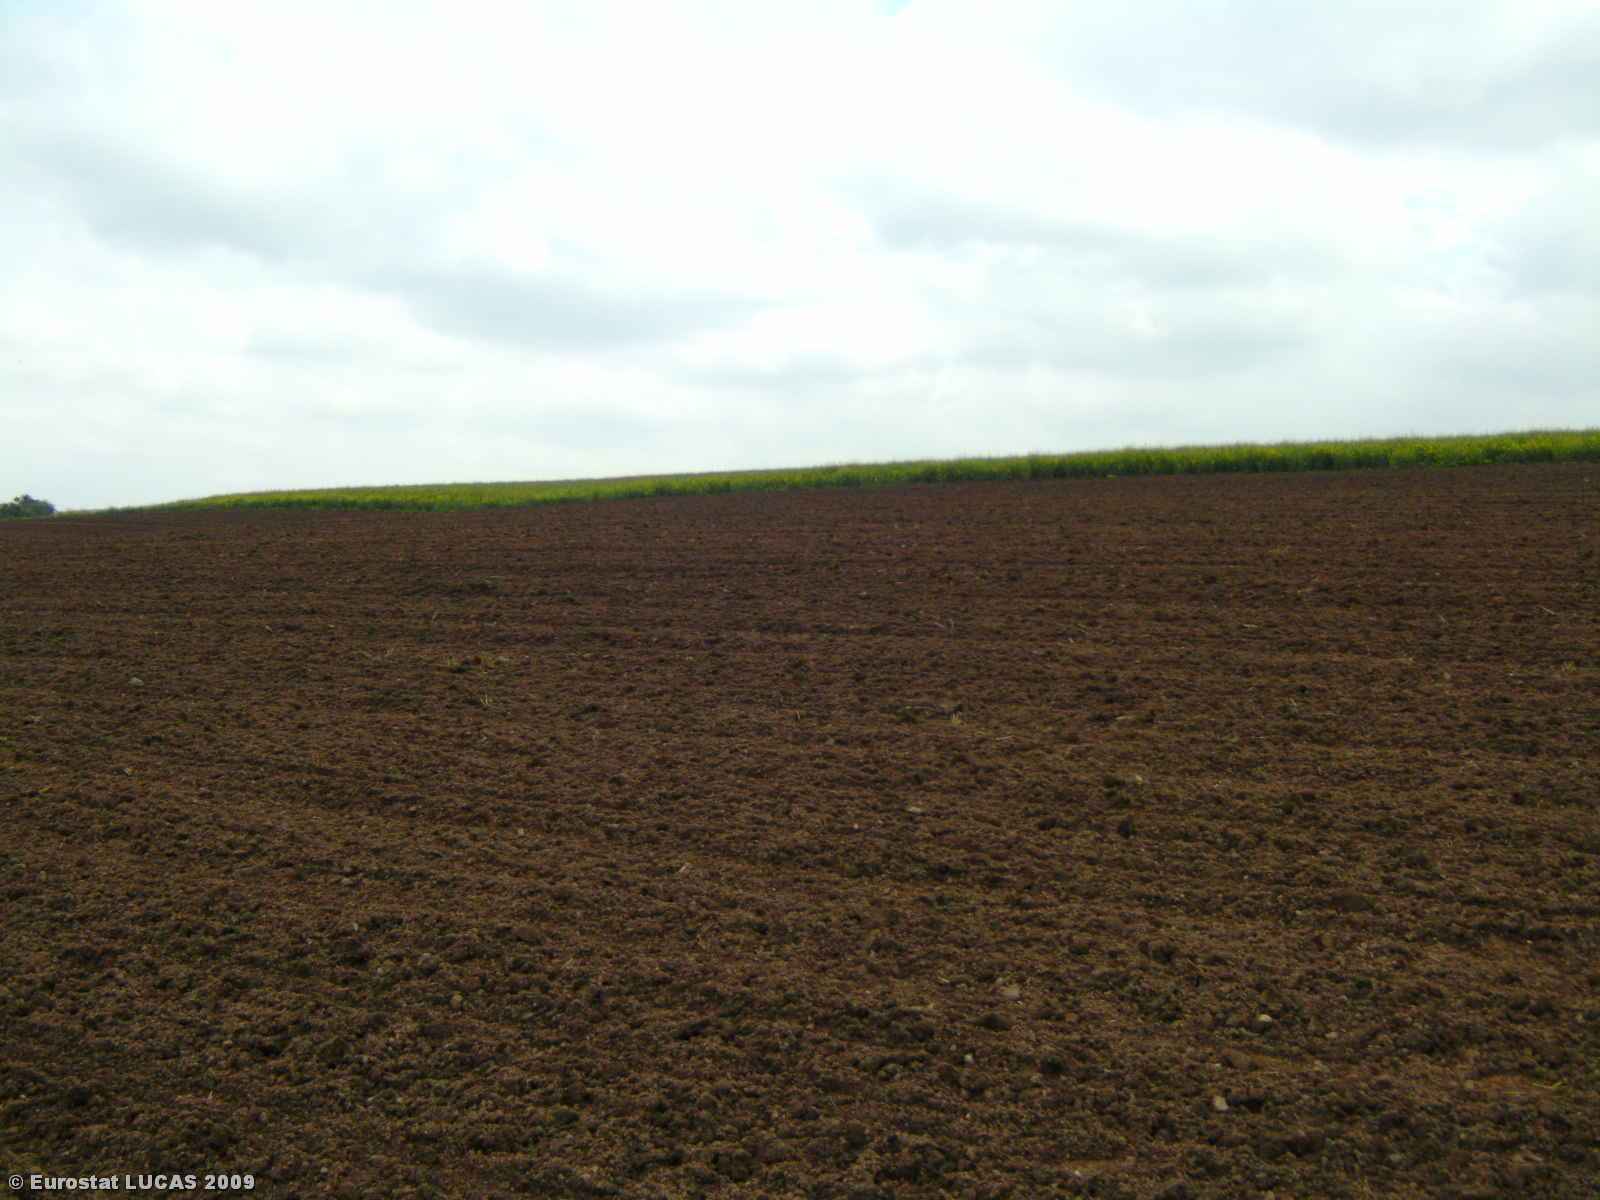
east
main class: Cropland
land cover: Maize
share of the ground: > 75 %
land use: Agriculture (excluding fallow land and kitchen gardens)
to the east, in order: Maize; Rape and turnip rape; Barley; Grassland without tree/shrub cover
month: May
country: LU
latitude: 49.7943
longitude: 6.1235
